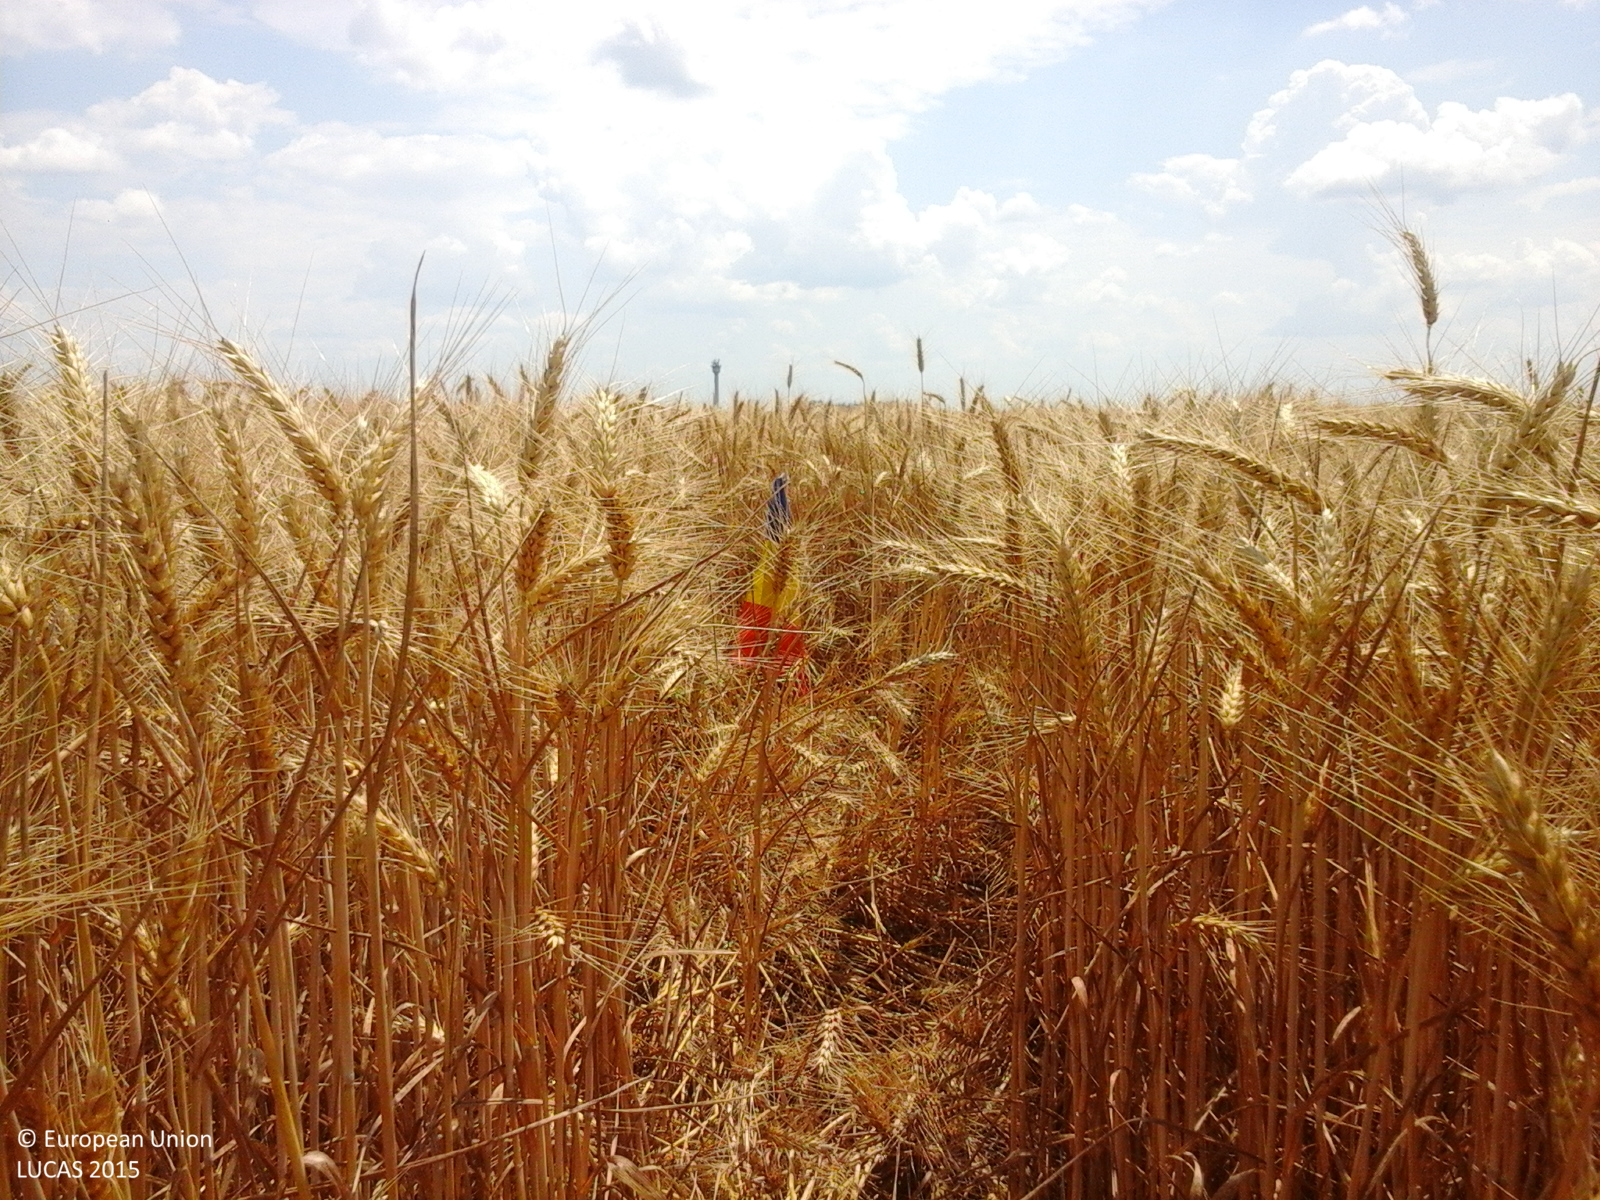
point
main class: Cropland
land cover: Common wheat
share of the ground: > 75 %
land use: Agriculture (excluding fallow land and kitchen gardens)
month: June
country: RO
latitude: 44.2353
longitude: 26.0145
